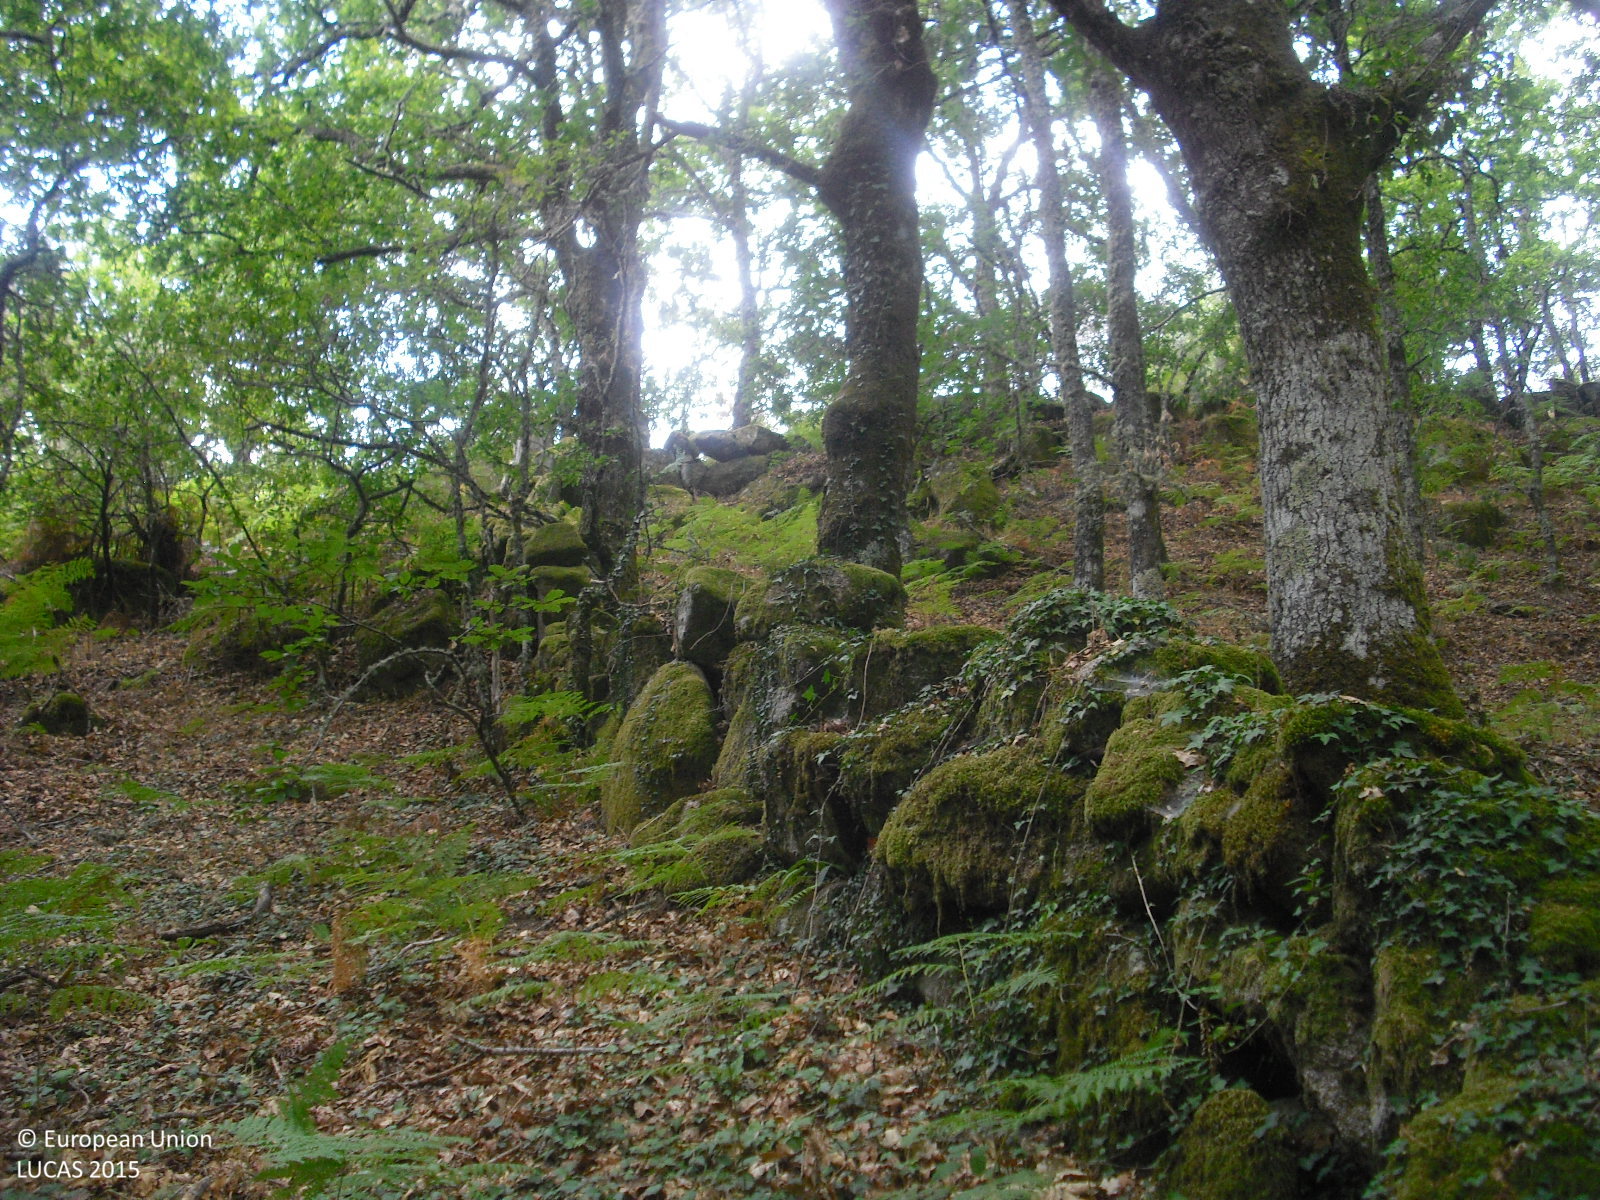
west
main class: Woodland
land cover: Broadleaved woodland
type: thermophilous deciduous forest
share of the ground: > 75 %
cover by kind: broadleaved forest trees 90 %, shrubs 10 %
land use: Forestry
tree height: > 5 m
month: July
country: ES
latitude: 42.3901
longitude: -7.6989
